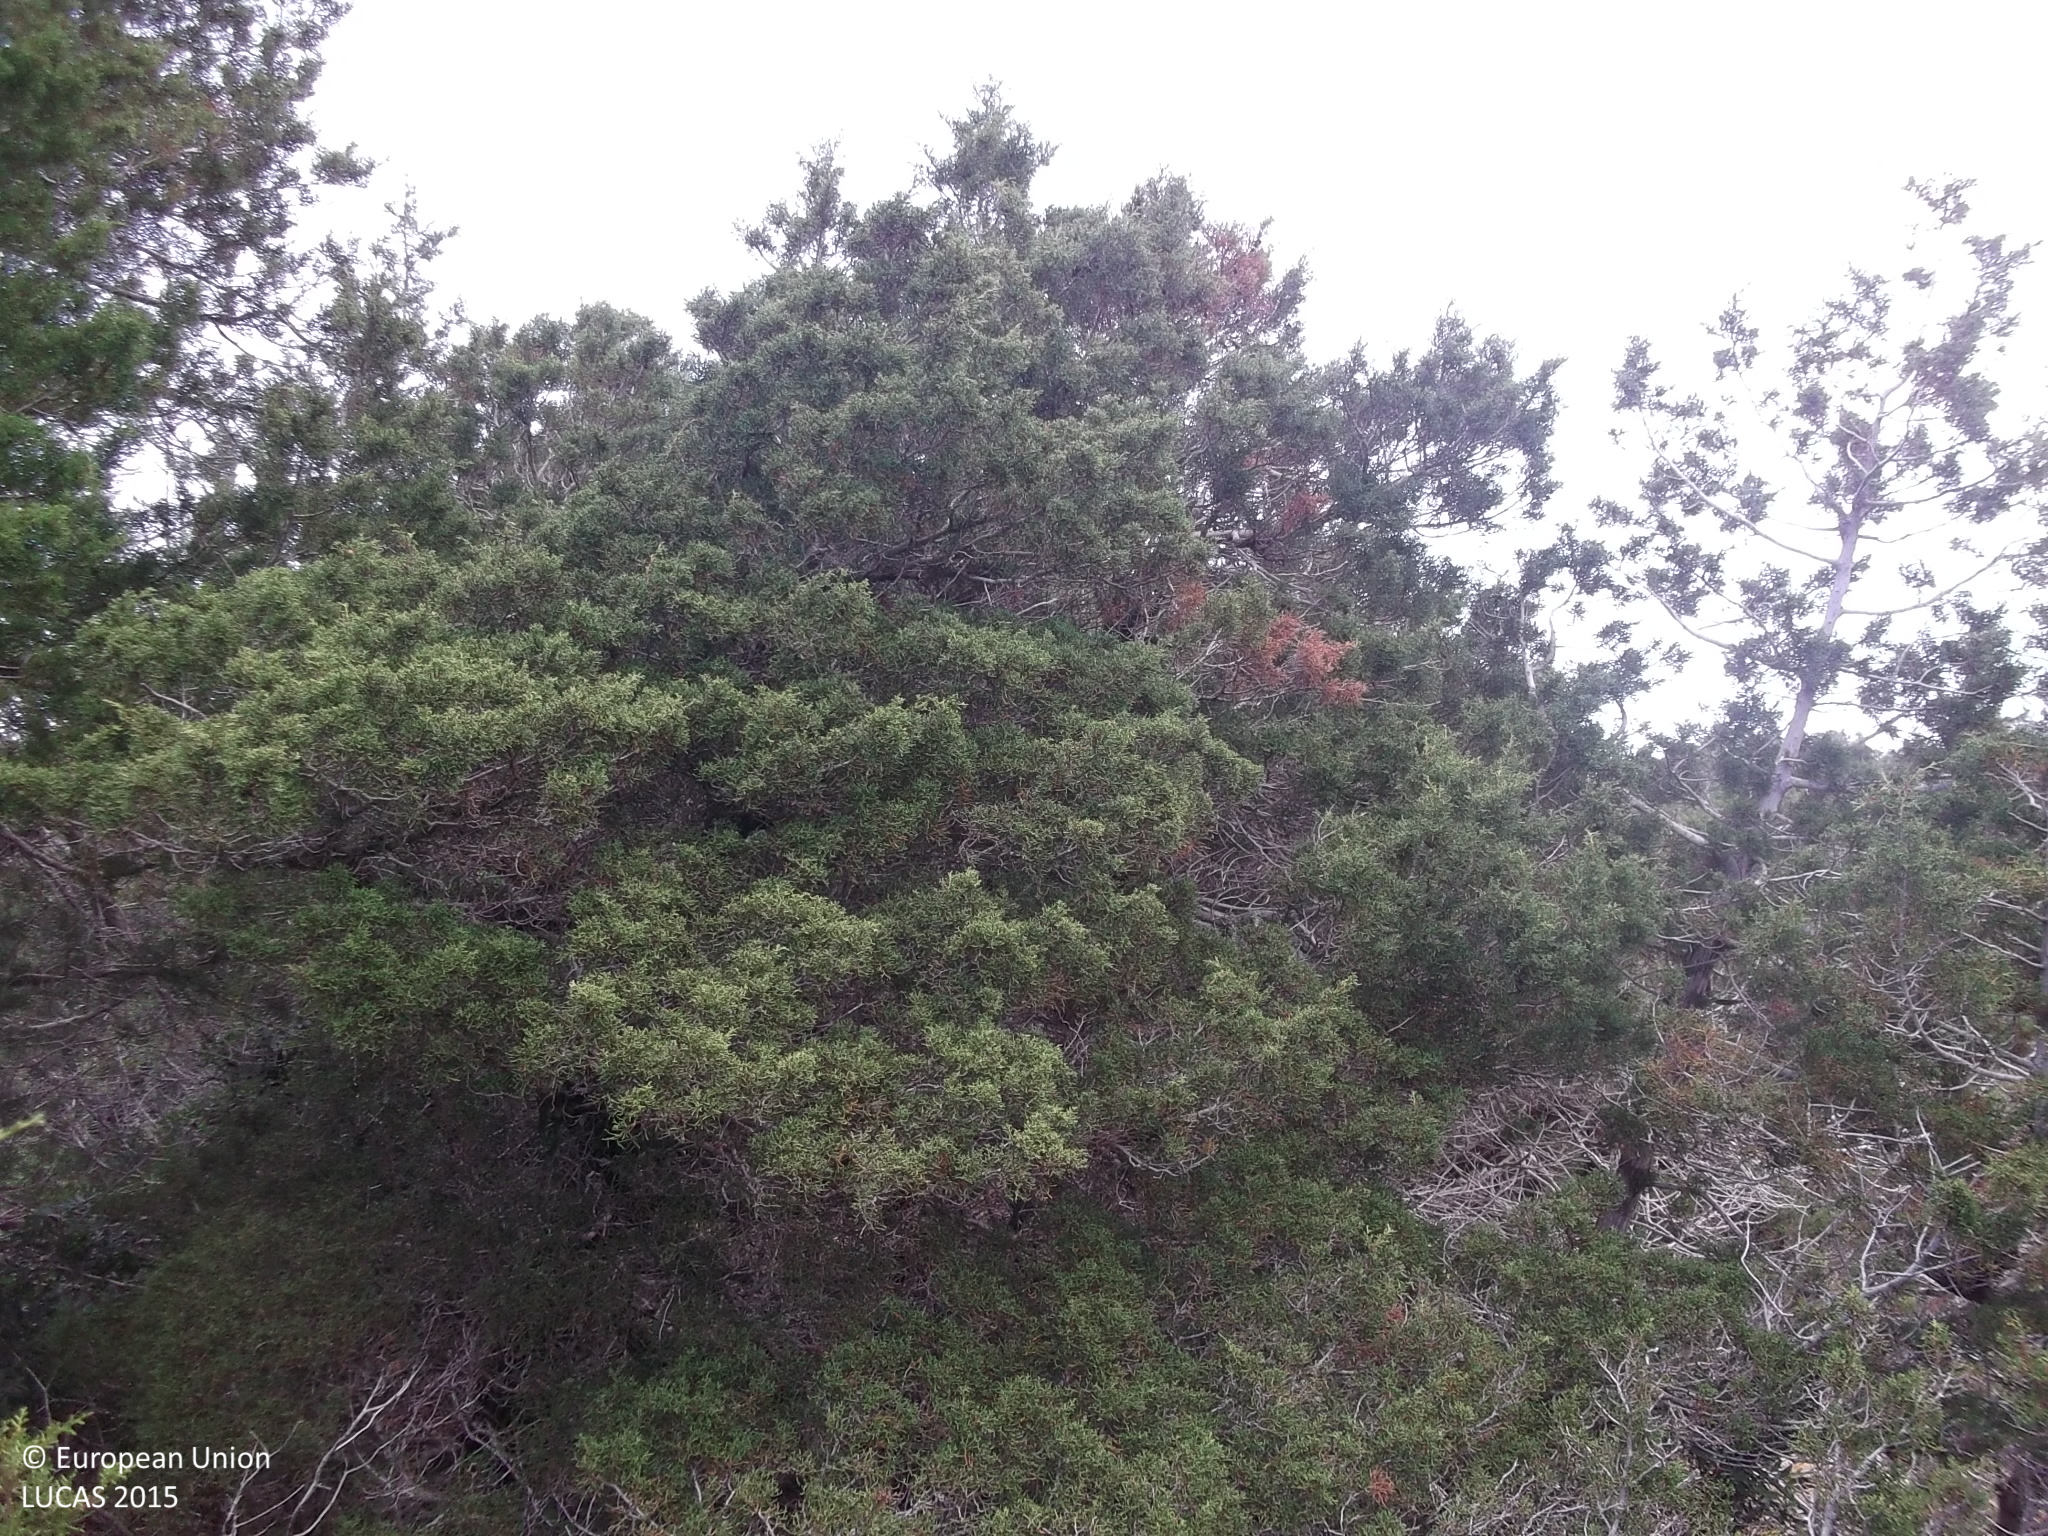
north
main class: Woodland
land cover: Other coniferous woodland
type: coniferous forest of the mediterranean region
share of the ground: > 75 %
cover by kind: coniferous forest trees 75 %, unconsolidated bare surface 15 %, shrubs 10 %
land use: Forestry
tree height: > 5 m
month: May
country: CY
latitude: 35.0611
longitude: 32.3100
